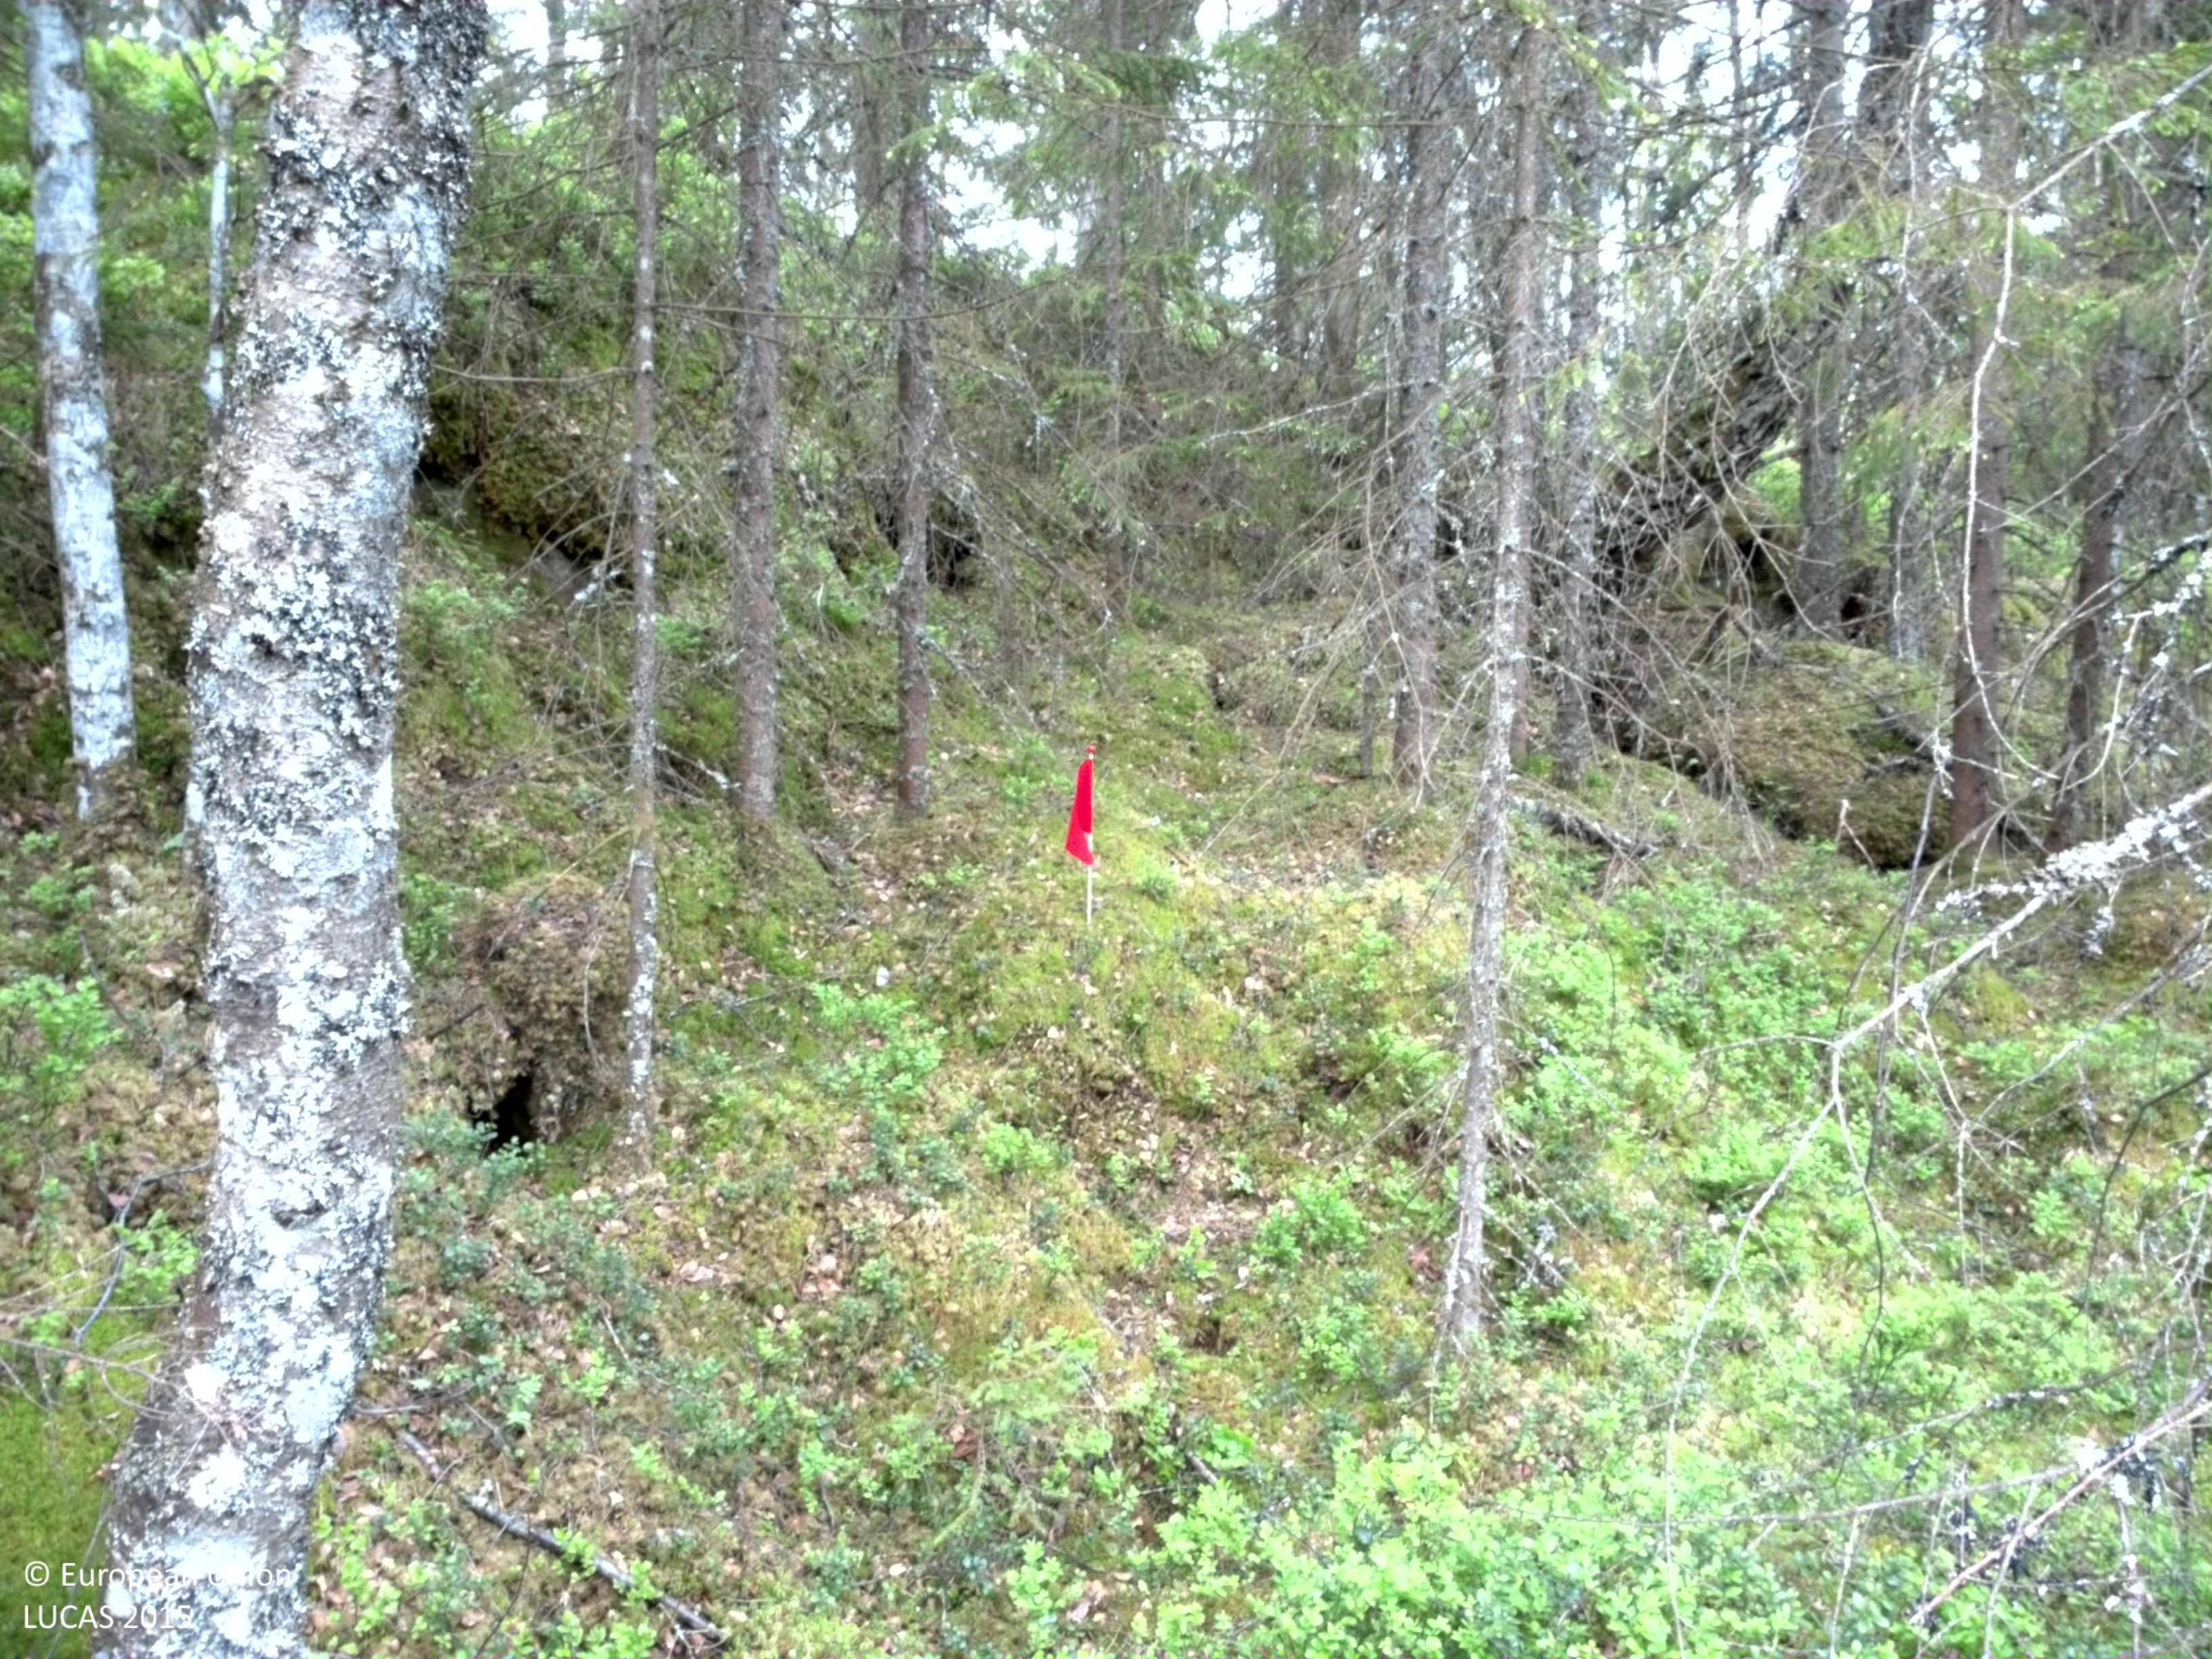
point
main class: Woodland
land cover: Spruce dominated coniferous woodland
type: boreal forest
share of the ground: 50 - 75 %
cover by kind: coniferous forest trees 60 %, shrubs 25 %, broadleaved forest trees 15 %
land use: Forestry
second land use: Amenities, museums, leisure
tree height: > 5 m
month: June
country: SE
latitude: 57.4623
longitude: 13.8463
